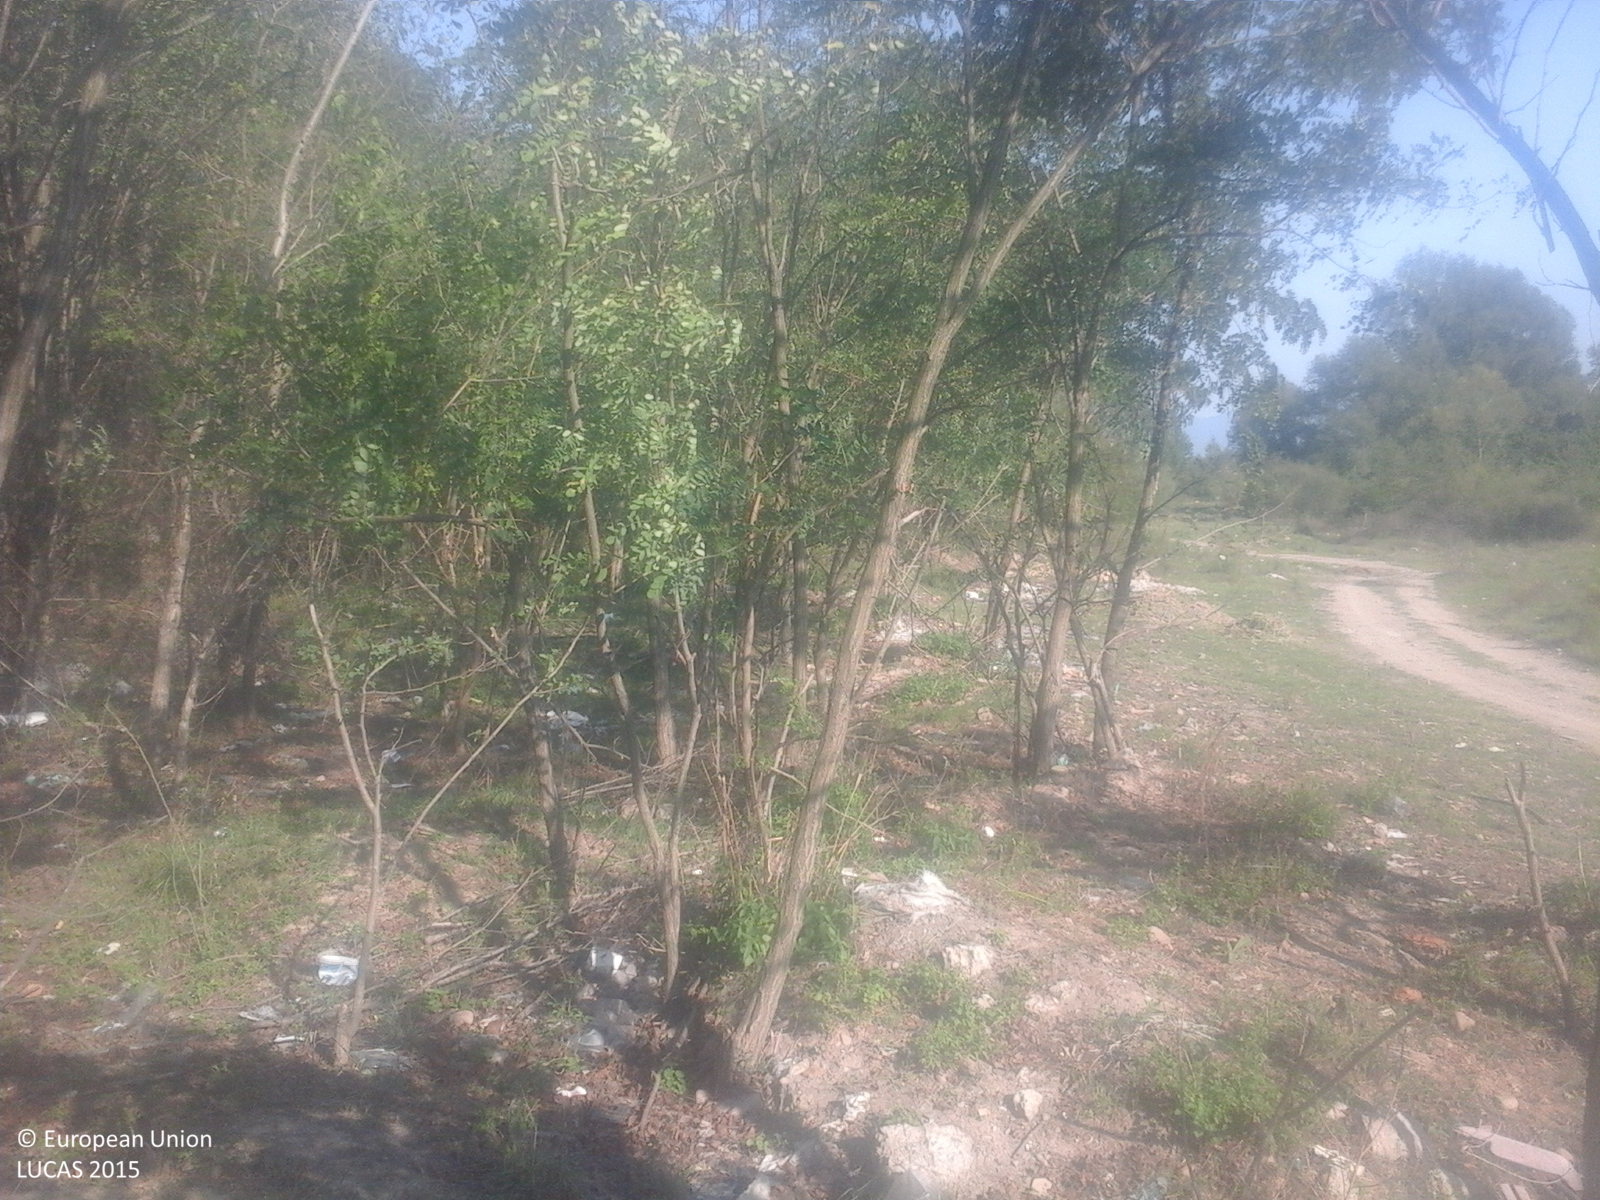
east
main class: Woodland
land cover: Broadleaved woodland
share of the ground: > 75 %
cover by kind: broadleaved forest trees 100 %
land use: Forestry
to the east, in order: Broadleaved woodland; Grassland without tree/shrub cover; Rocks and stones; Inland fresh running water; Rocks and stones; Grassland without tree/shrub cover; Broadleaved woodland
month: September
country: RO
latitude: 46.6319
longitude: 22.3676
